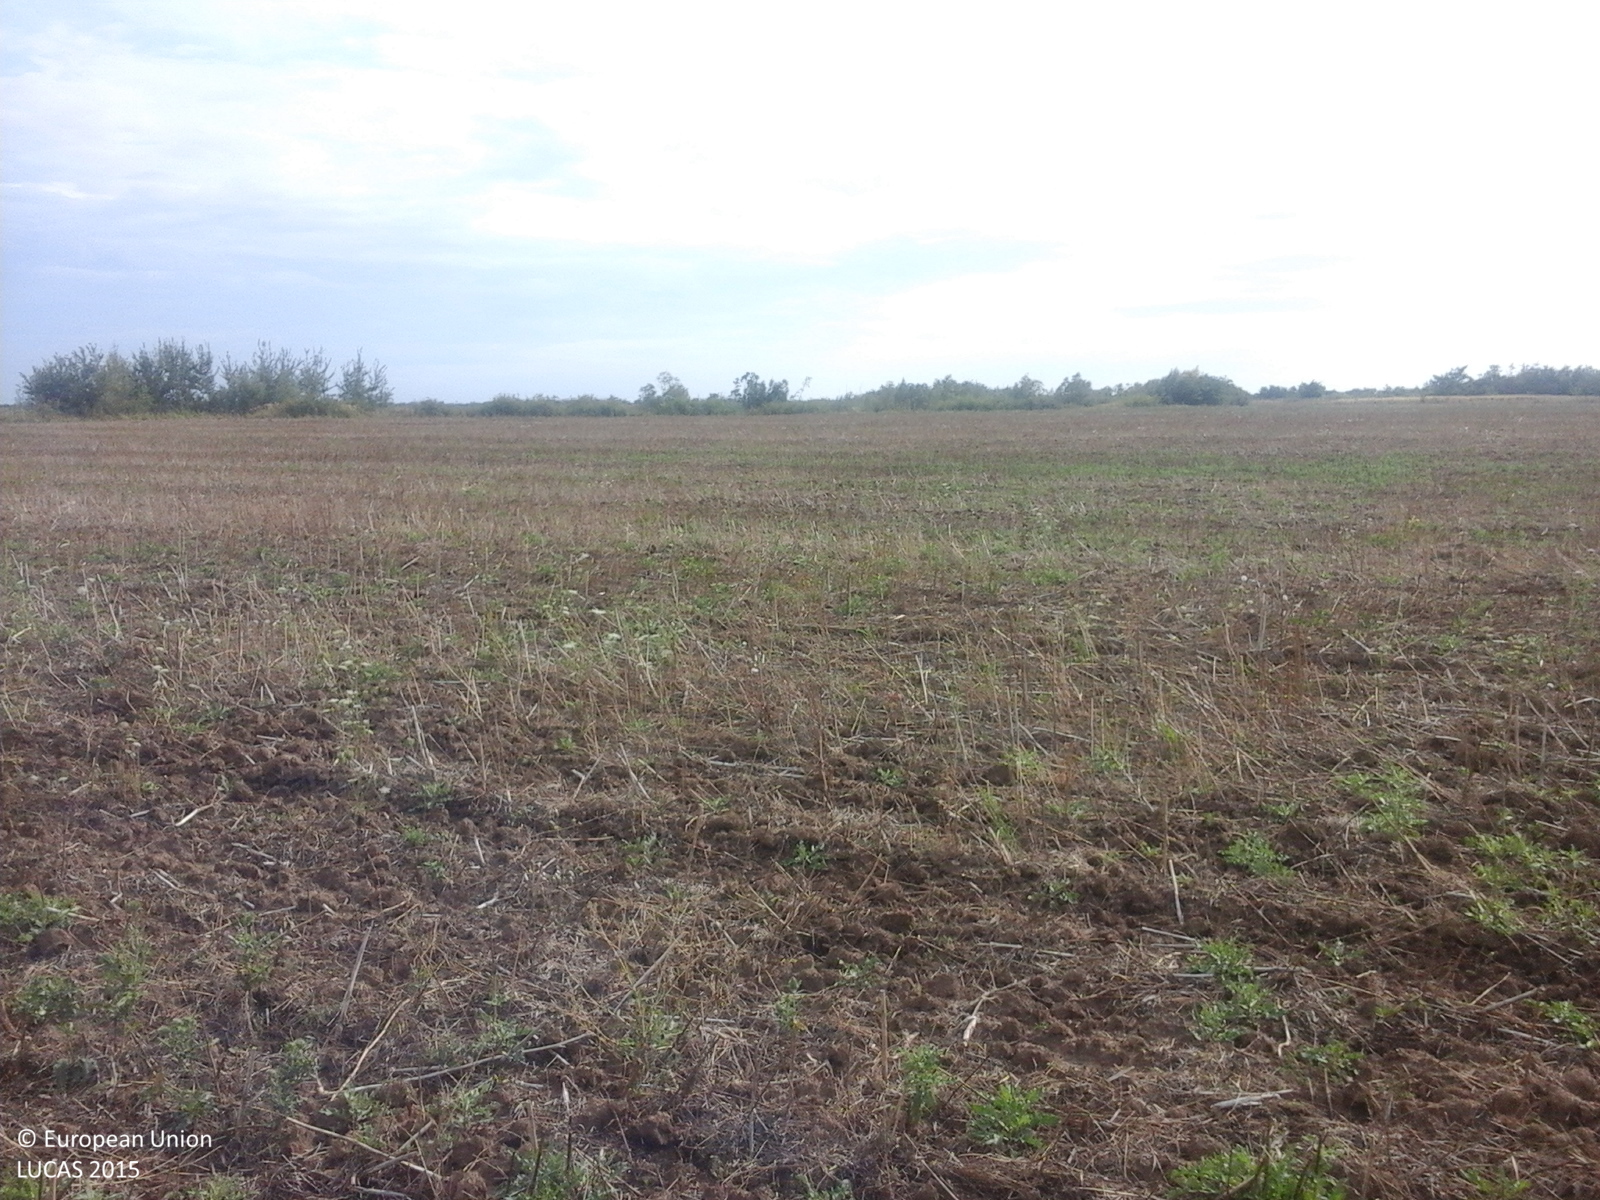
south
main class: Cropland
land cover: Rape and turnip rape
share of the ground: < 10 %
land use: Agriculture (excluding fallow land and kitchen gardens)
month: August
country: RO
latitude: 45.3887
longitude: 21.2816
